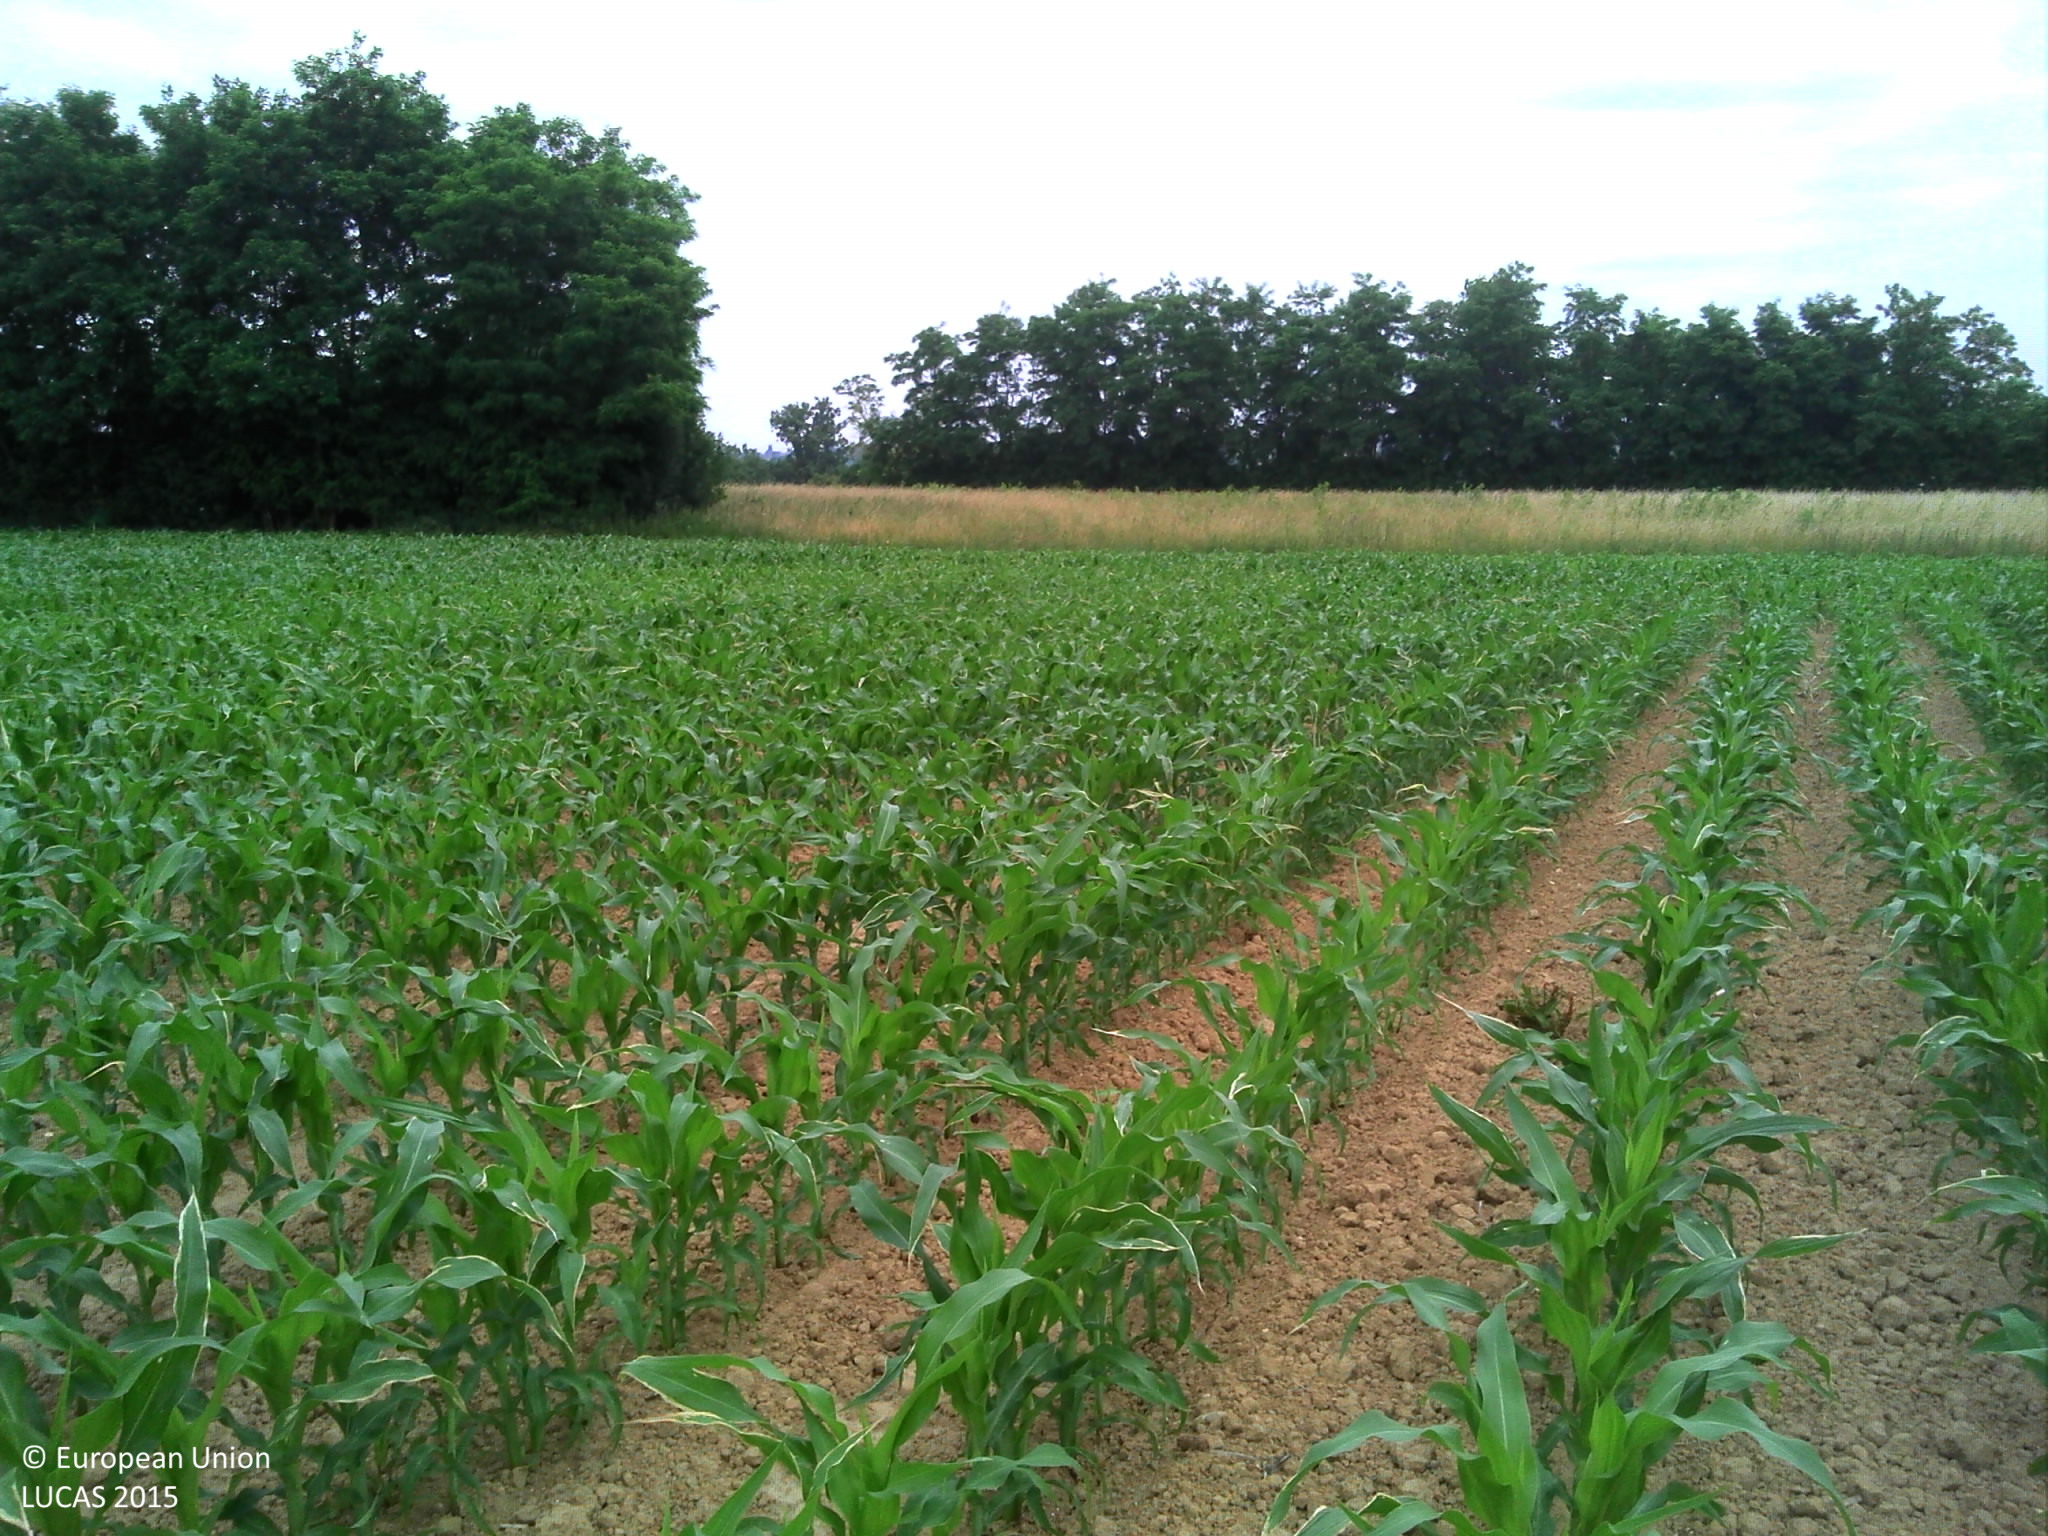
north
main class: Cropland
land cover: Maize
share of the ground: 25 - 50 %
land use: Agriculture (excluding fallow land and kitchen gardens)
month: June
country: FR
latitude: 46.1543
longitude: 4.8362
